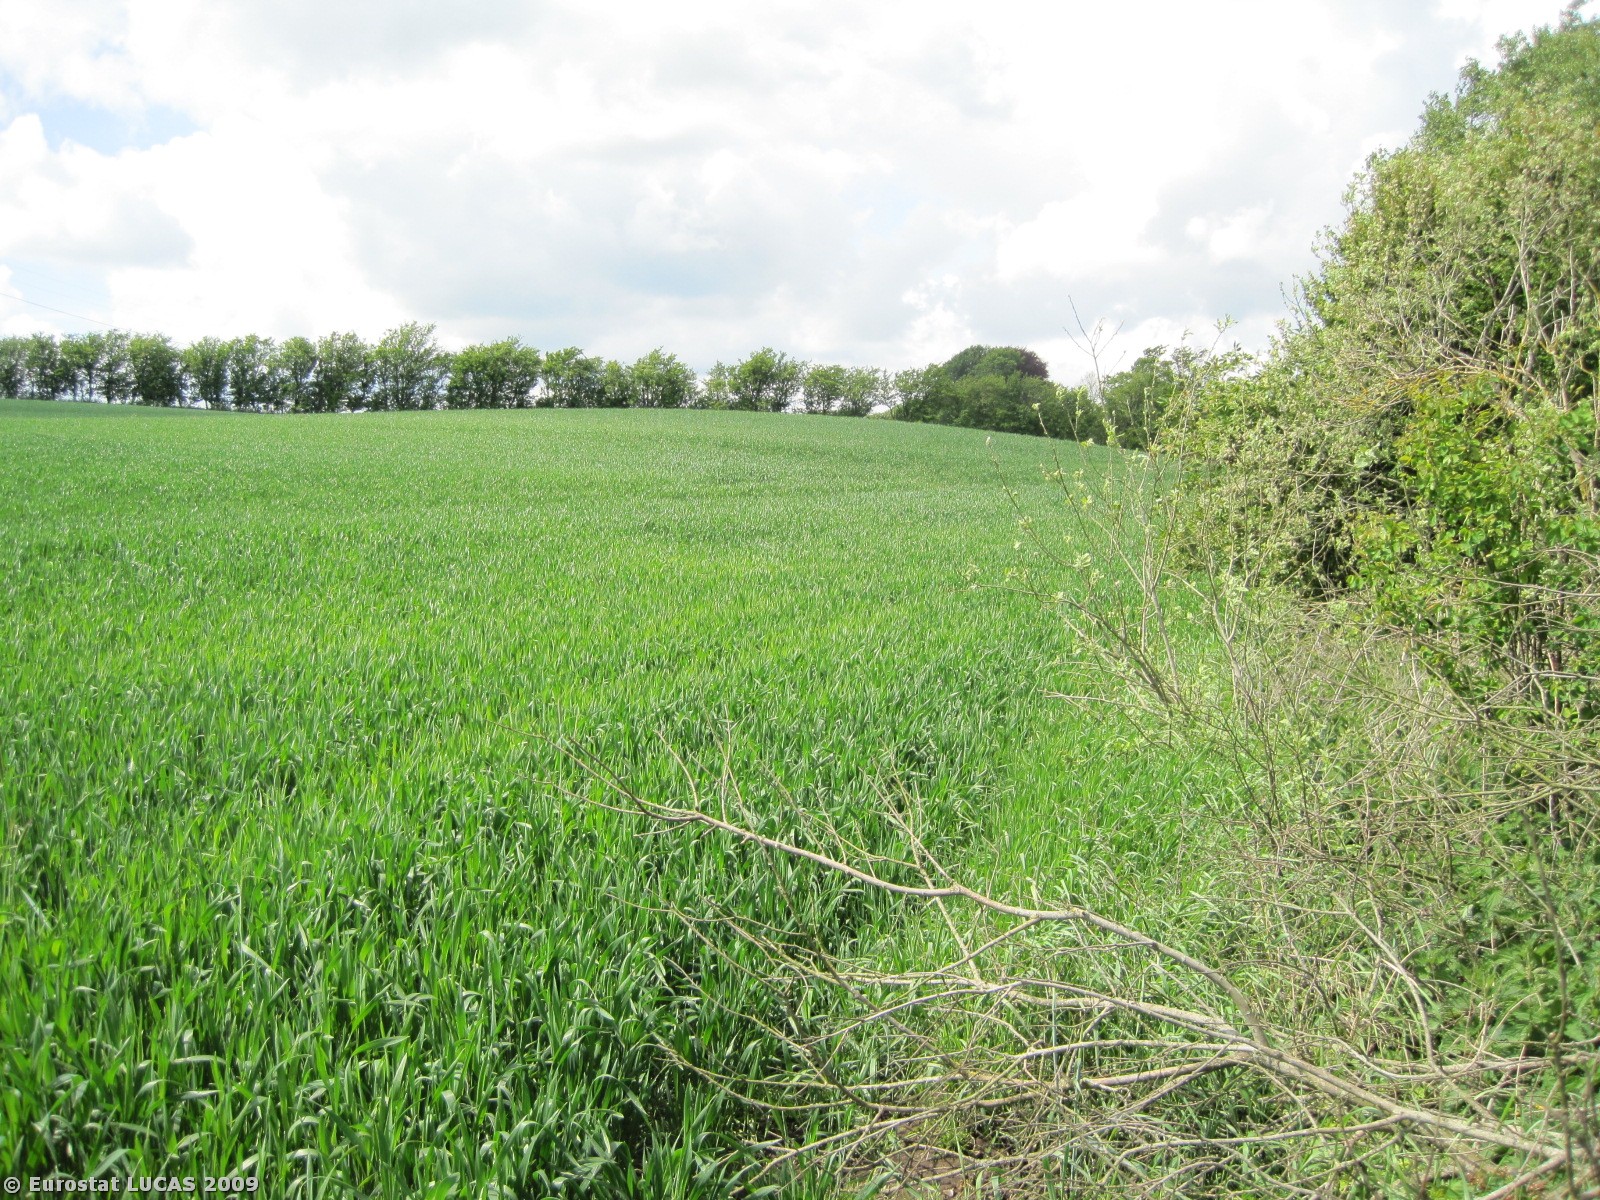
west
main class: Woodland
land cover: Broadleaved woodland
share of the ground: > 75 %
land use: Unused
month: May
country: DK
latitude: 56.7089
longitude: 9.7879
